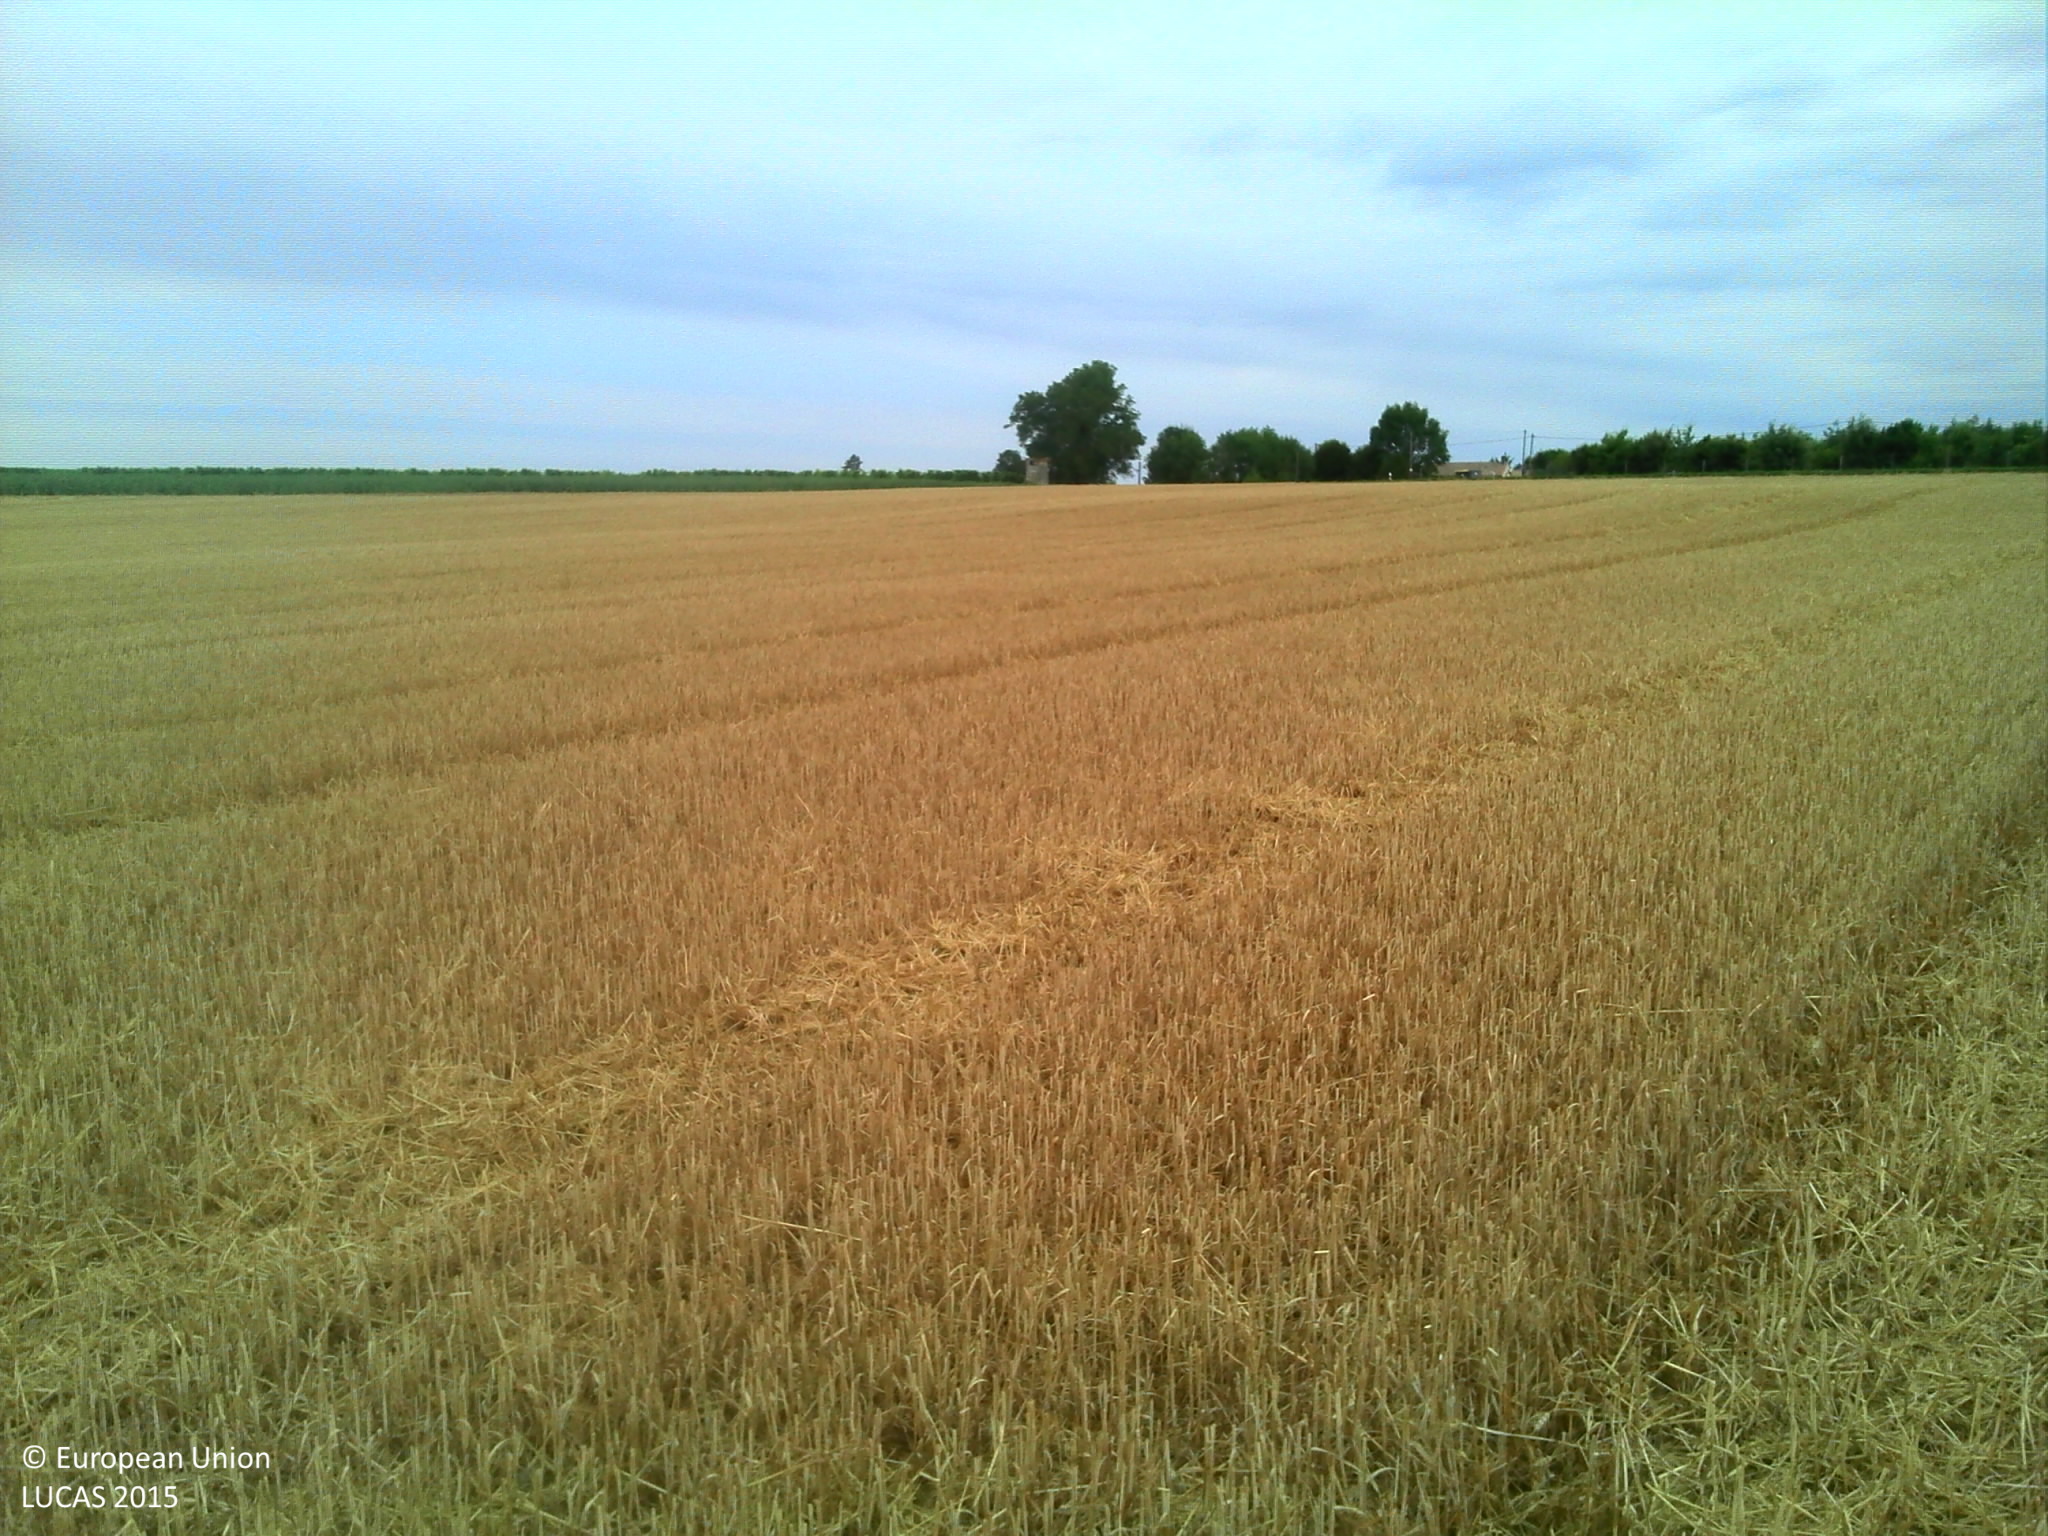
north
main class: Cropland
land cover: Durum wheat
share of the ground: > 75 %
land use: Agriculture (excluding fallow land and kitchen gardens)
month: July
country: FR
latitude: 45.4344
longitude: -0.6709
